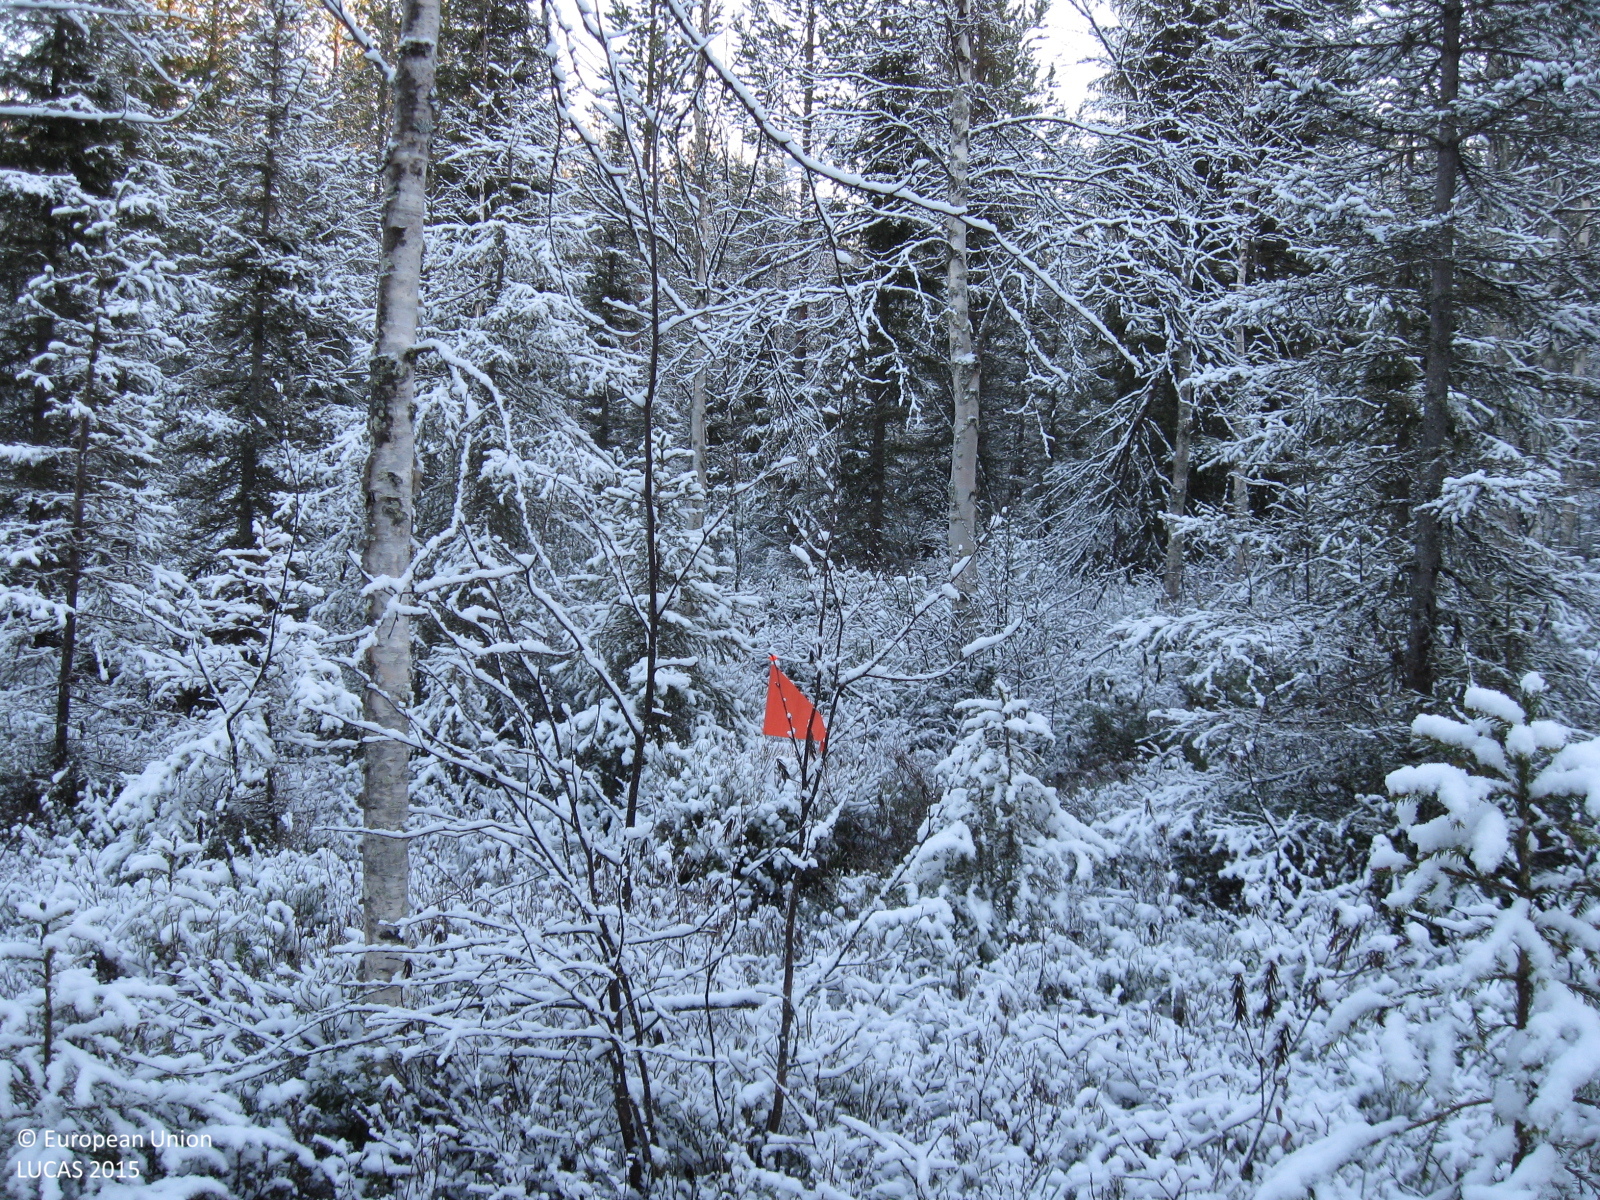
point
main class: Woodland
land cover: Spruce dominated mixed woodland
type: boreal forest
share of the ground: 50 - 75 %
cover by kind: coniferous forest trees 35 %, broadleaved forest trees 25 %, shrubs 20 %, herbaceous plants 10 %, lichens and mosses 10 %
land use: Forestry
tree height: > 5 m
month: October
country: SE
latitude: 66.3430
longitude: 21.4659
